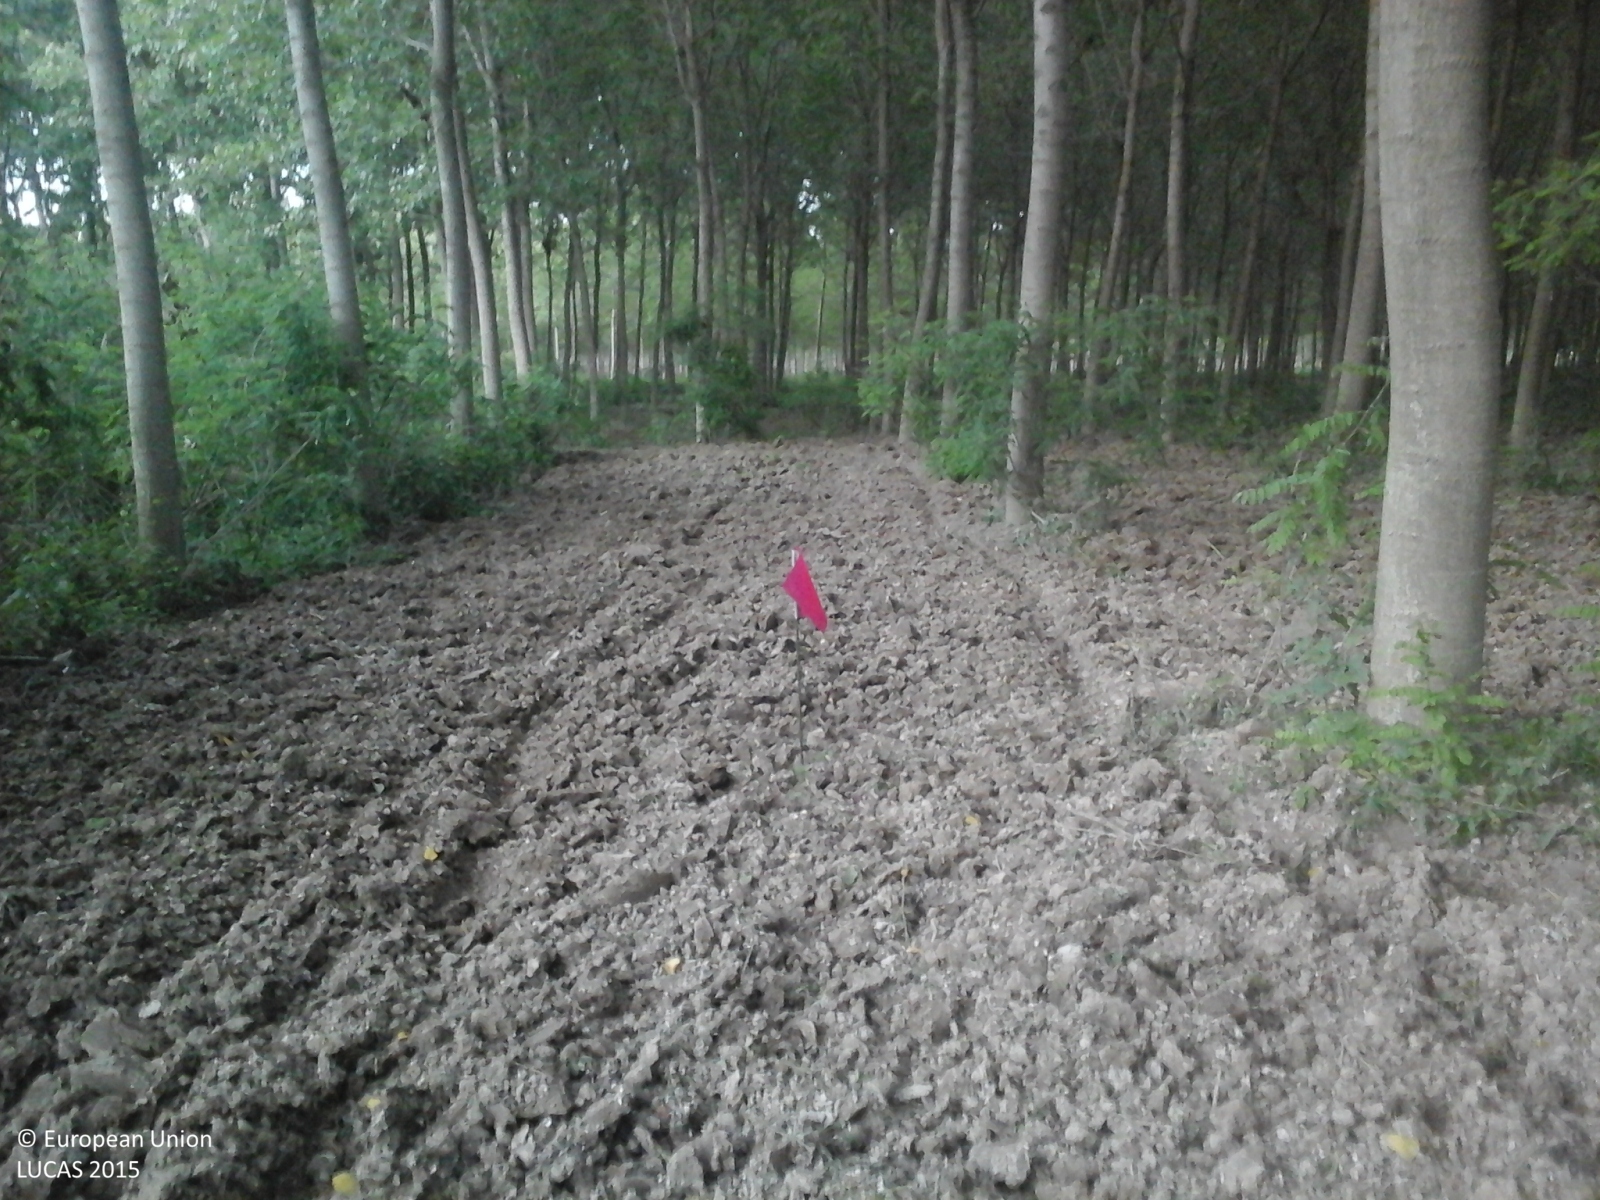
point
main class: Woodland
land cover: Broadleaved woodland
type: non-riverine alder, birch or aspen forest
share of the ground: > 75 %
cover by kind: broadleaved forest trees 100 %
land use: Forestry
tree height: > 5 m
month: May
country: IT
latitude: 45.0680
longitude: 10.9000
